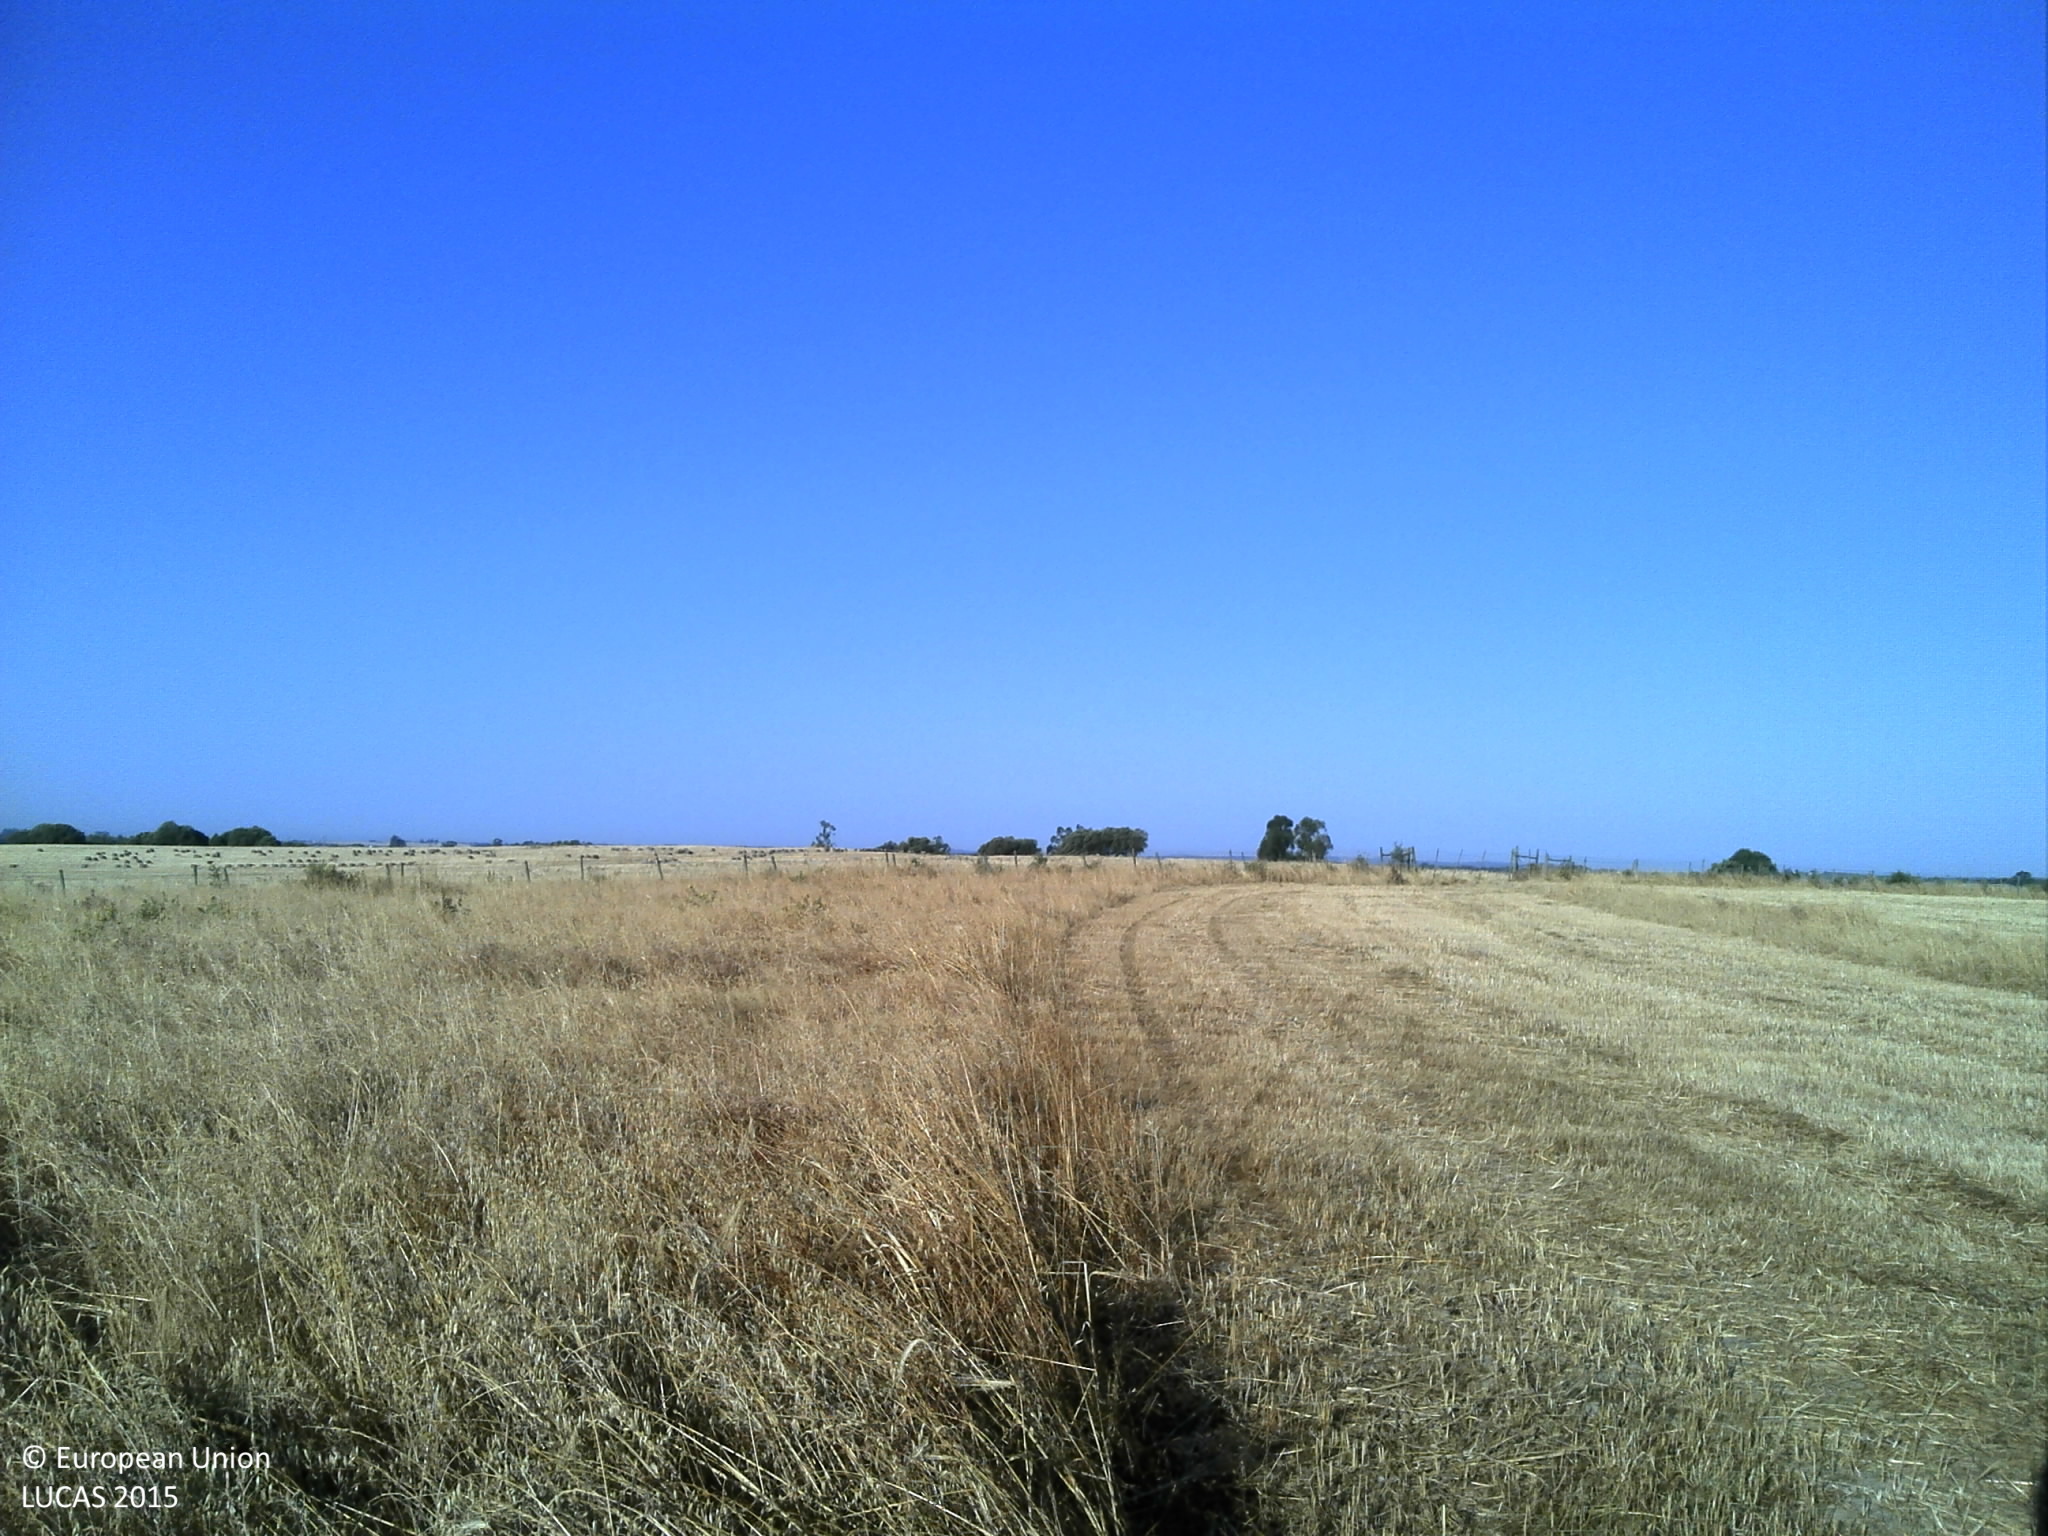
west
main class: Cropland
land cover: Oats
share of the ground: > 75 %
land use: Agriculture (excluding fallow land and kitchen gardens)
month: June
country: PT
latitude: 38.4933
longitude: -8.0065
